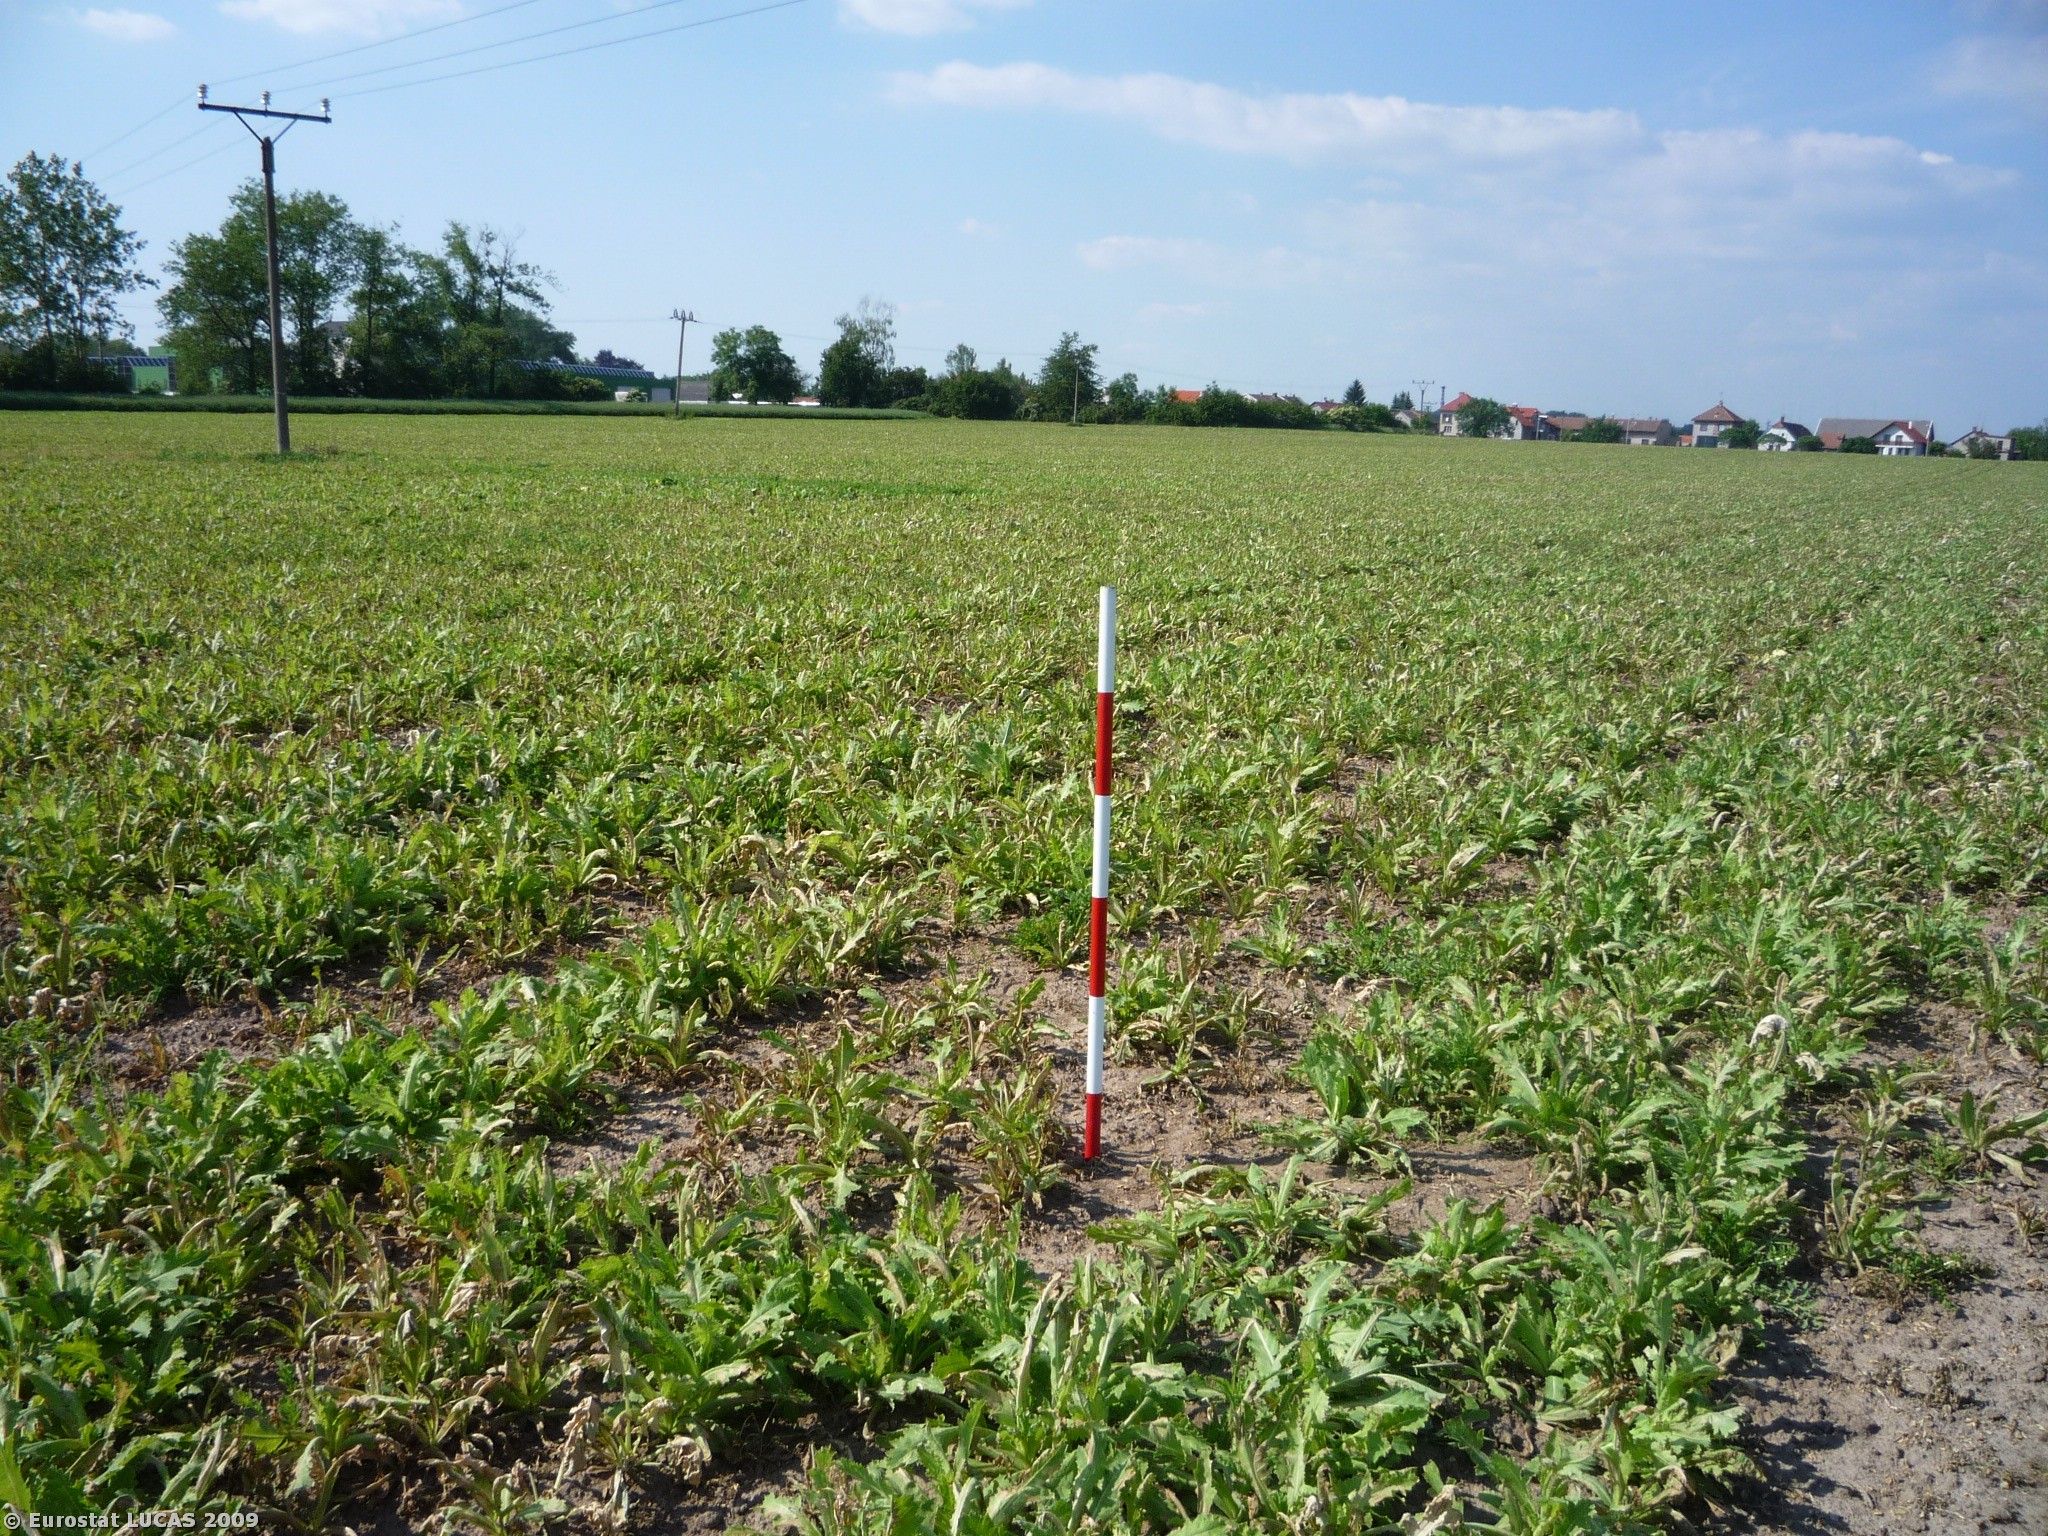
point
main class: Cropland
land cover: Other fibre and oleaginous crops
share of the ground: > 75 %
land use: Agriculture (excluding fallow land and kitchen gardens)
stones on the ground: < 10 %
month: May
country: CZ
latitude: 50.2173
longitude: 15.7930
